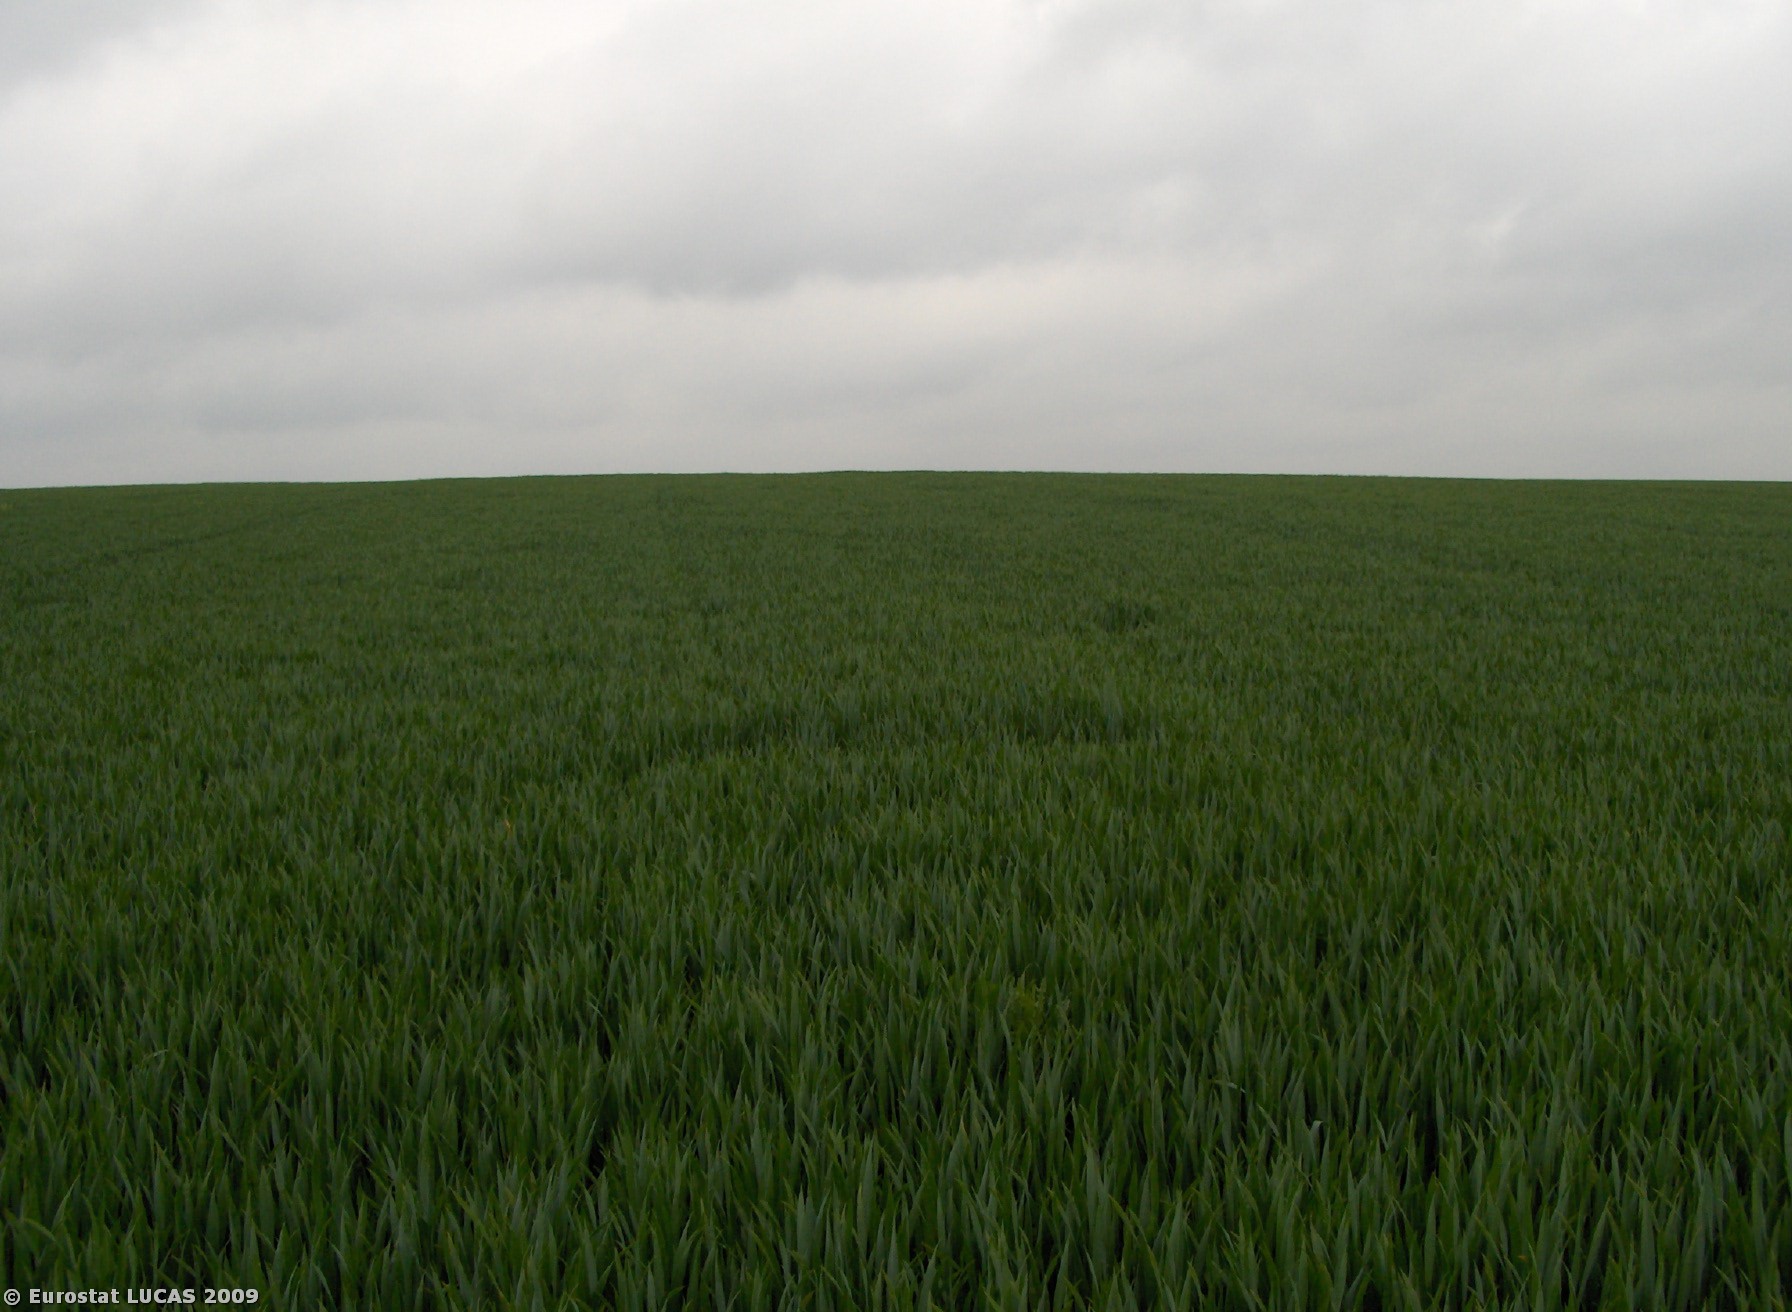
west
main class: Cropland
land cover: Common wheat
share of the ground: > 75 %
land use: Agriculture (excluding fallow land and kitchen gardens)
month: May
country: CZ
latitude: 49.3992
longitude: 17.1617
